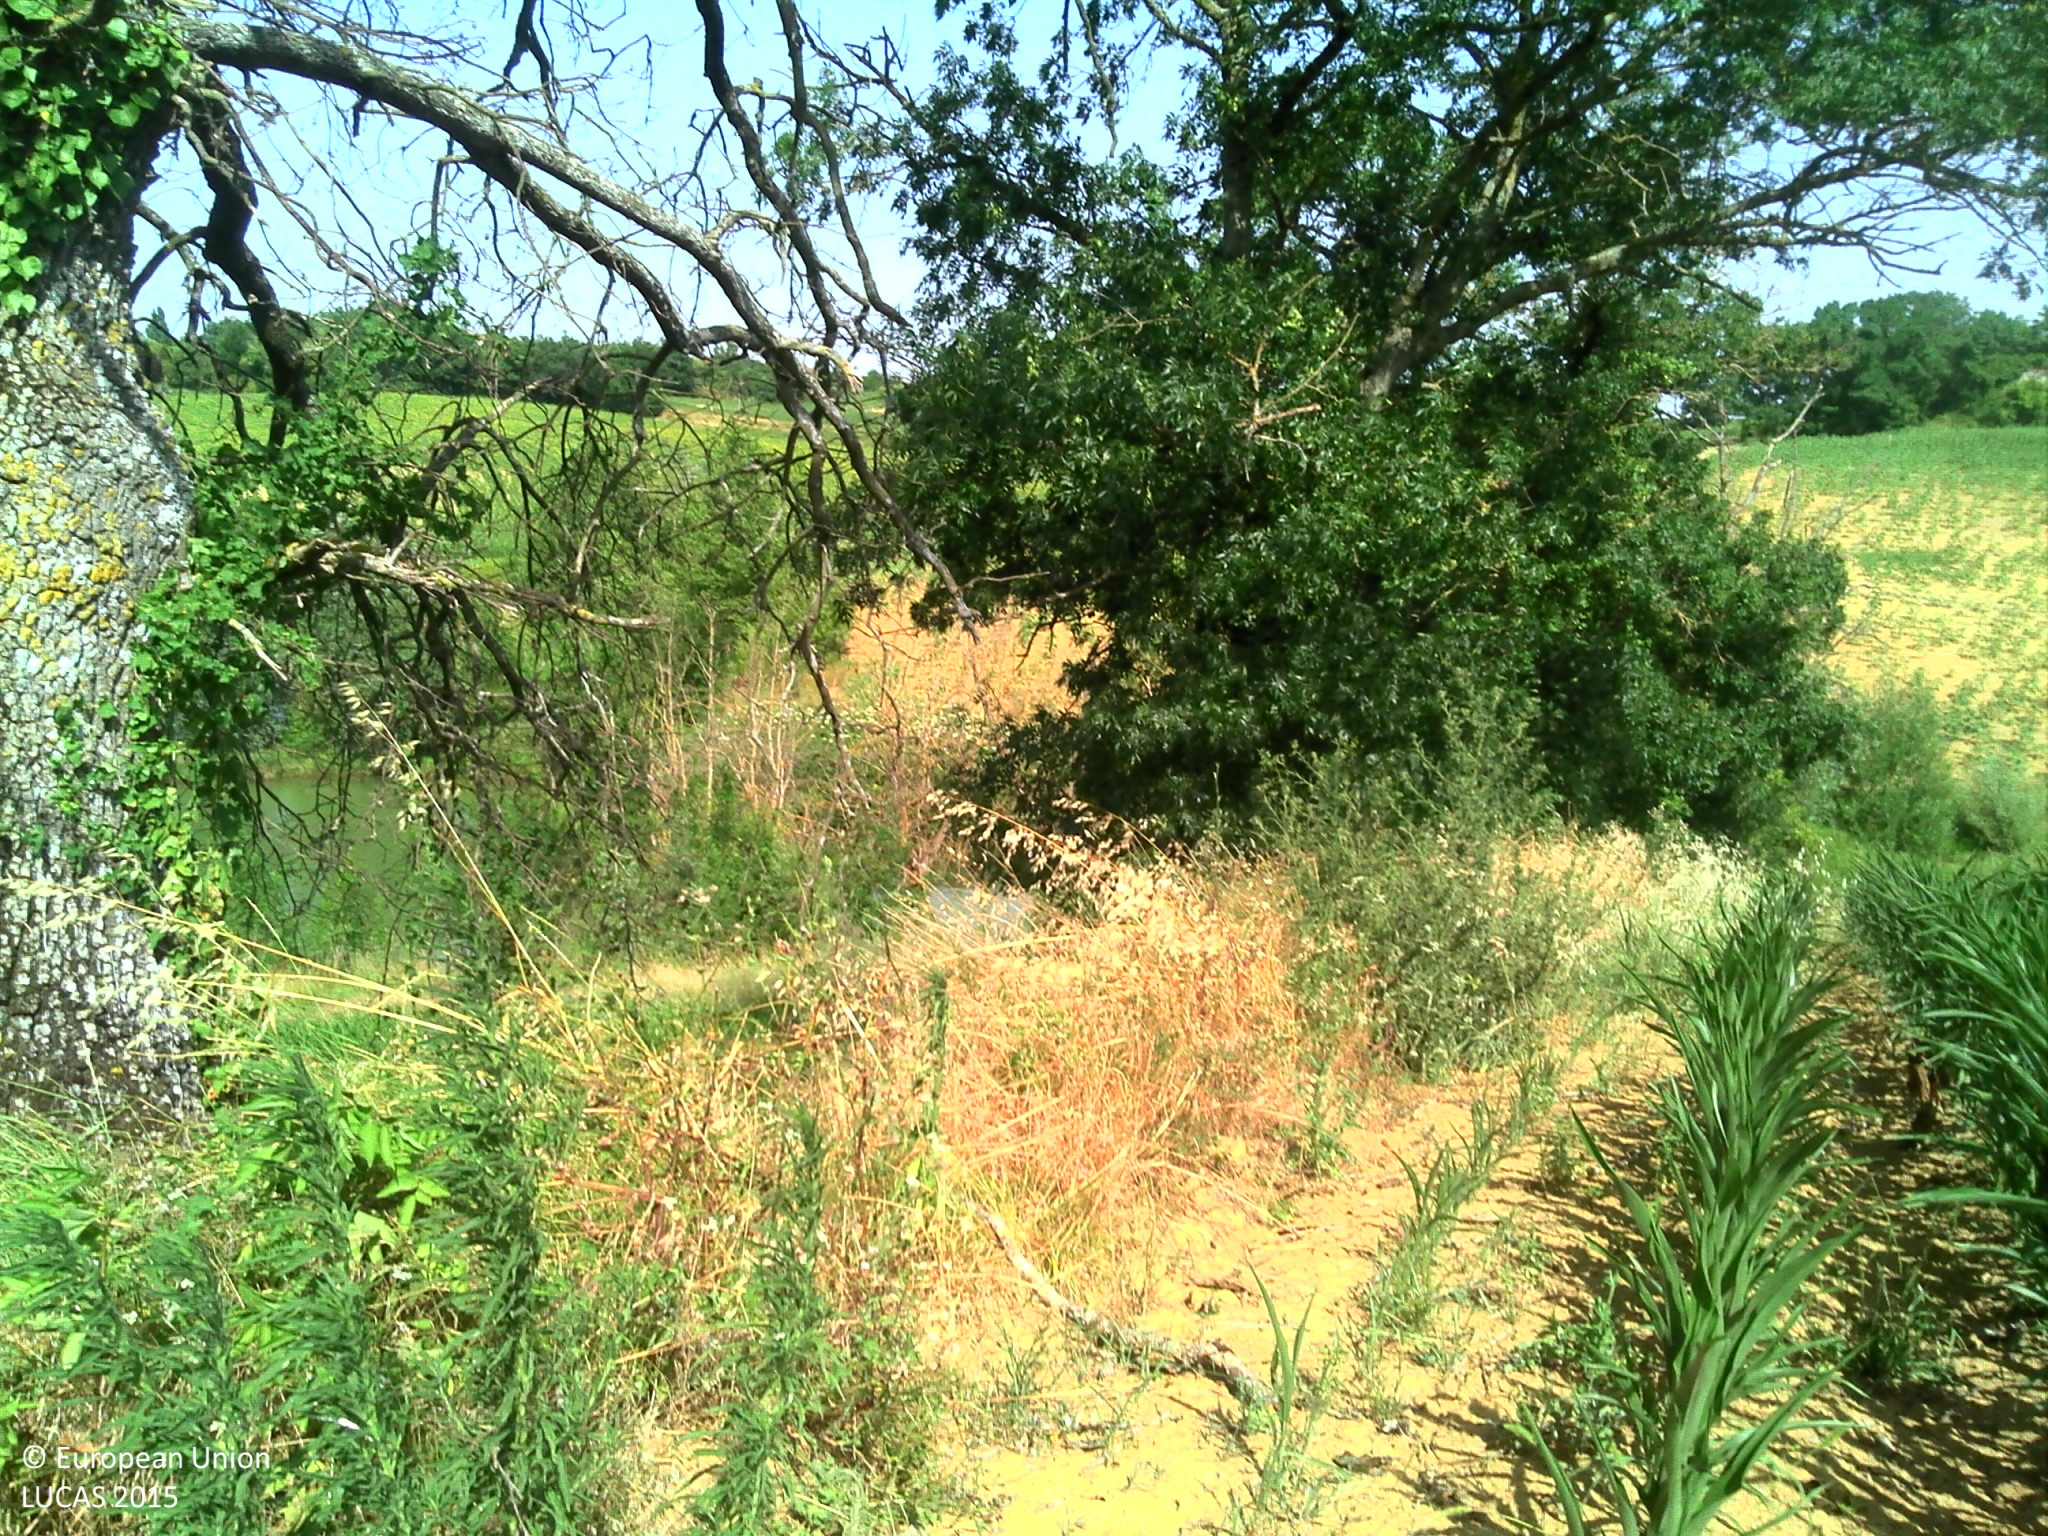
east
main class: Cropland
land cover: Maize
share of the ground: > 75 %
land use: Agriculture (excluding fallow land and kitchen gardens)
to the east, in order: Maize; Lines of trees; Spontaneously vegetated surfaces; Maize; Spontaneously vegetated surfaces; Inland fresh water bodies; Single bushes/trees; Spontaneously vegetated surfaces; Sunflower; Electric lines; Sunflower
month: July
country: FR
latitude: 43.5502
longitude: 1.7483
